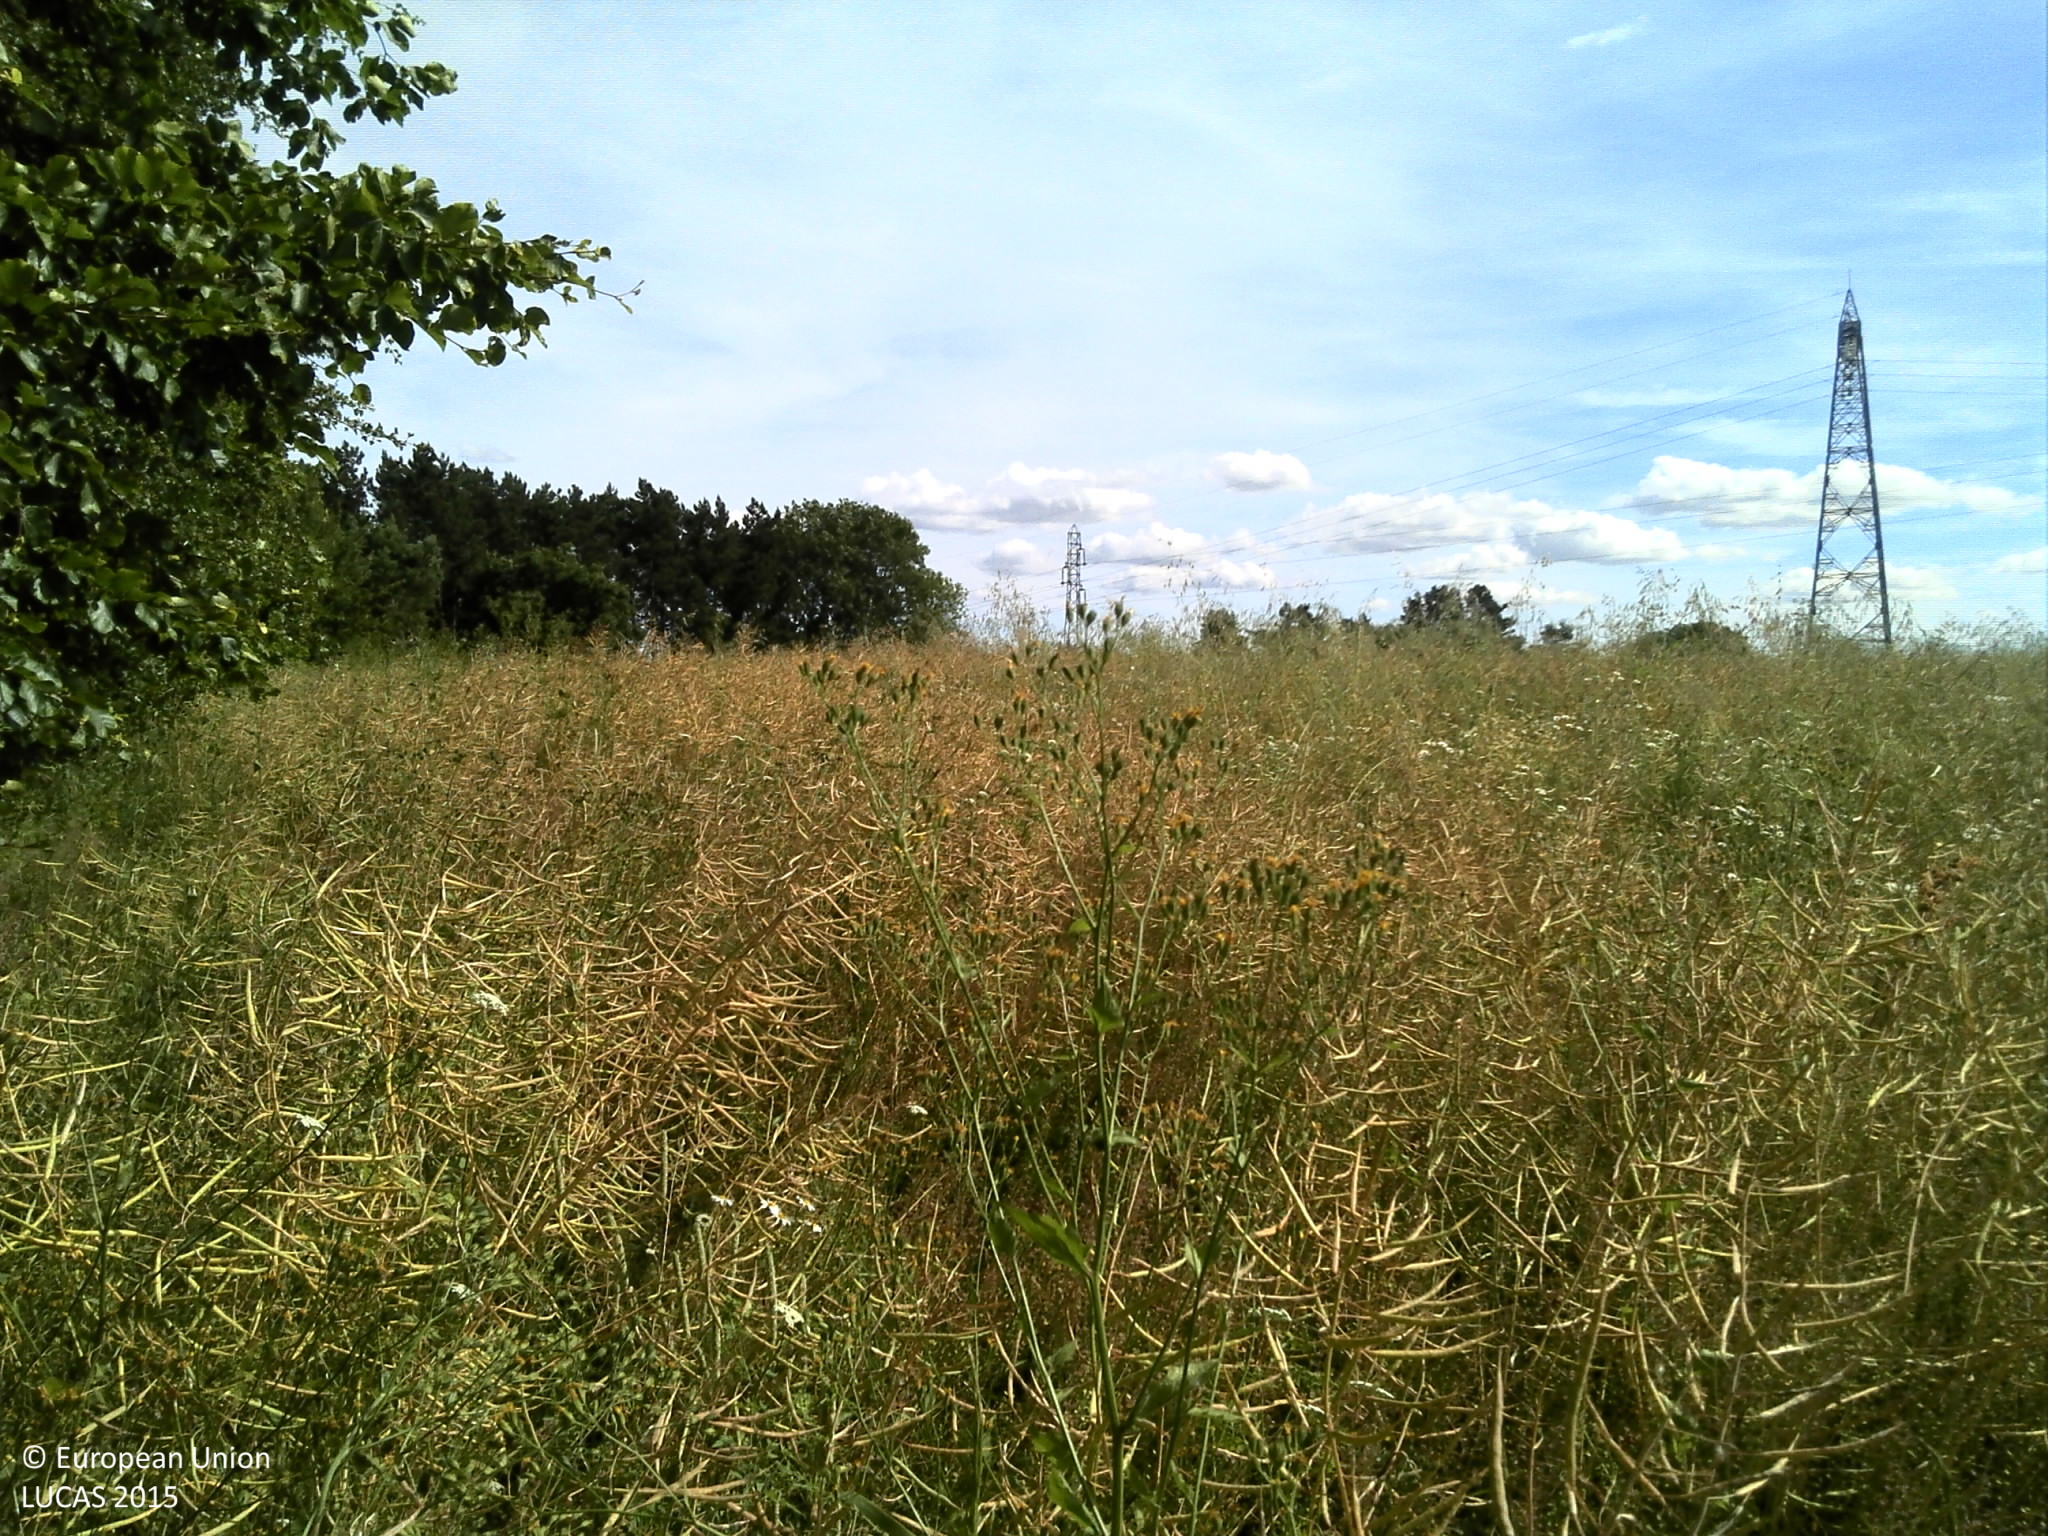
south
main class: Cropland
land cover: Rape and turnip rape
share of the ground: > 75 %
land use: Agriculture (excluding fallow land and kitchen gardens)
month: June
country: FR
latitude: 49.3227
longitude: 6.0233
